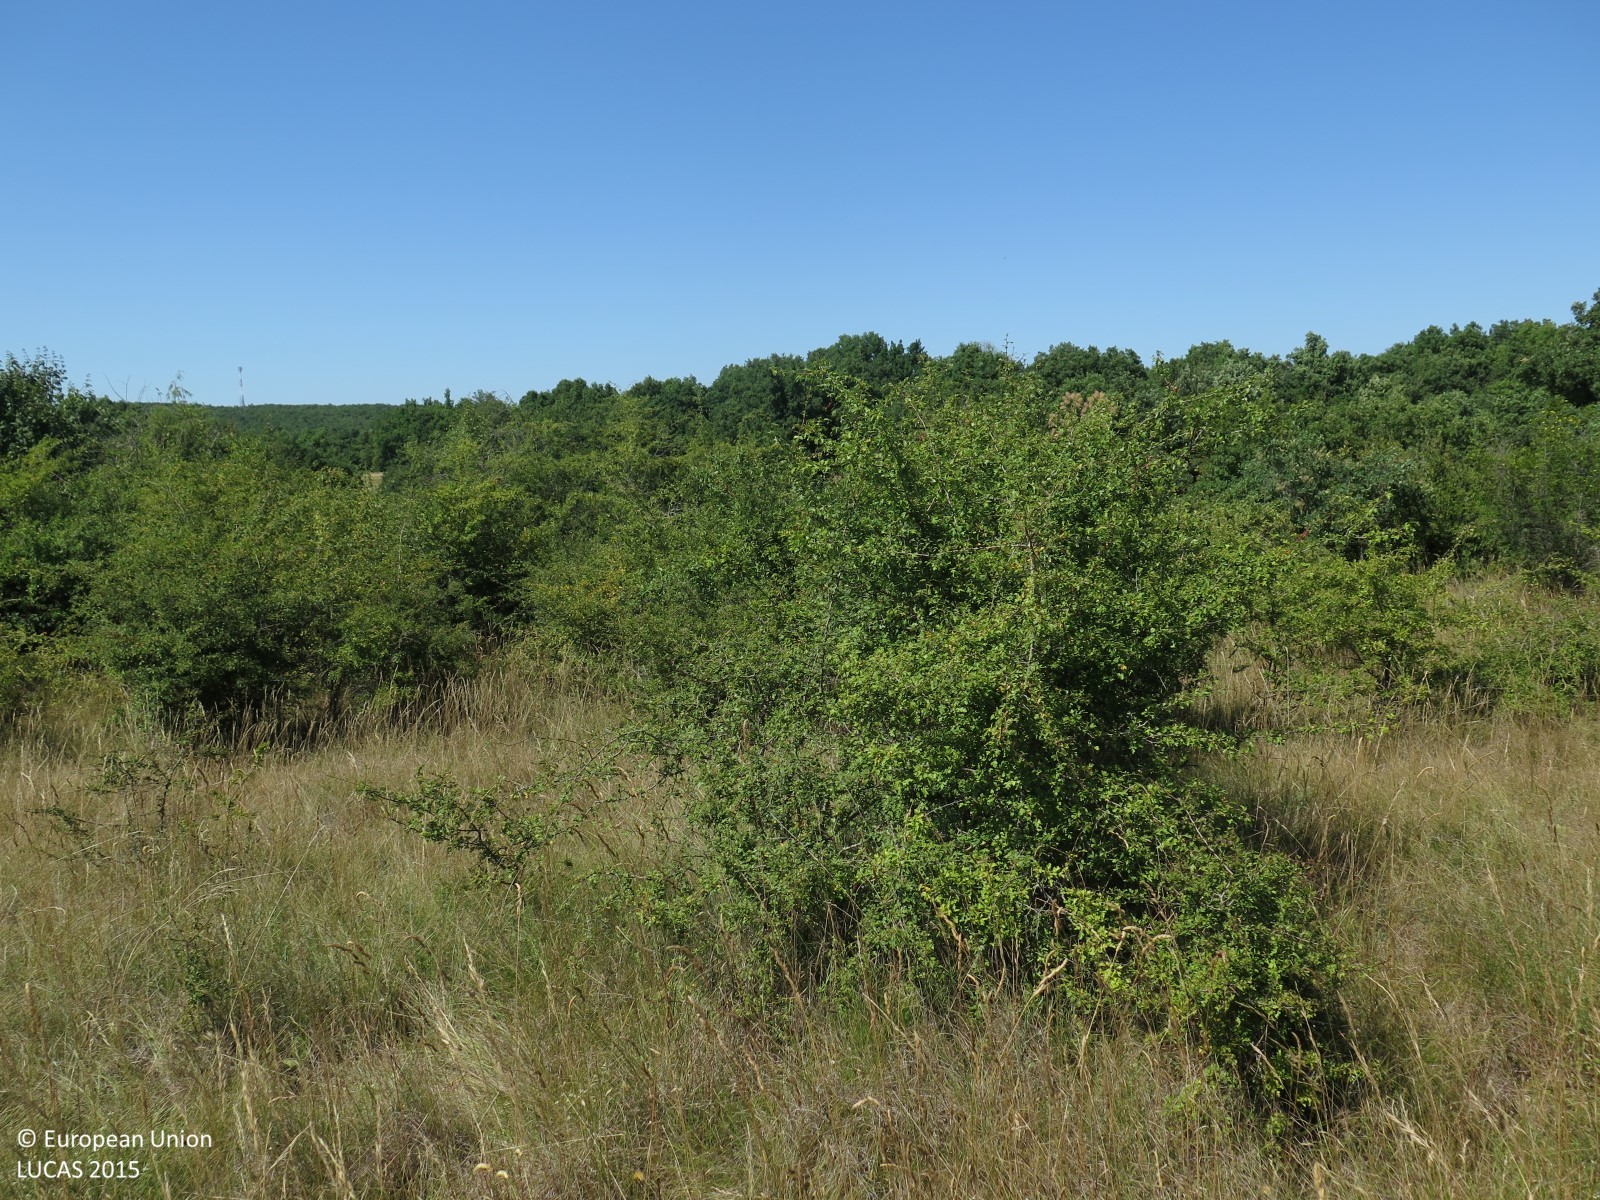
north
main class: Grassland
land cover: Grassland with sparse tree/shrub cover
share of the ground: > 75 %
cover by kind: herbaceous plants 90 %, broadleaved forest trees 5 %, shrubs 5 %
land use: Abandoned areas
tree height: < 5 m
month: July
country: HR
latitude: 45.4031
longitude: 13.7129
